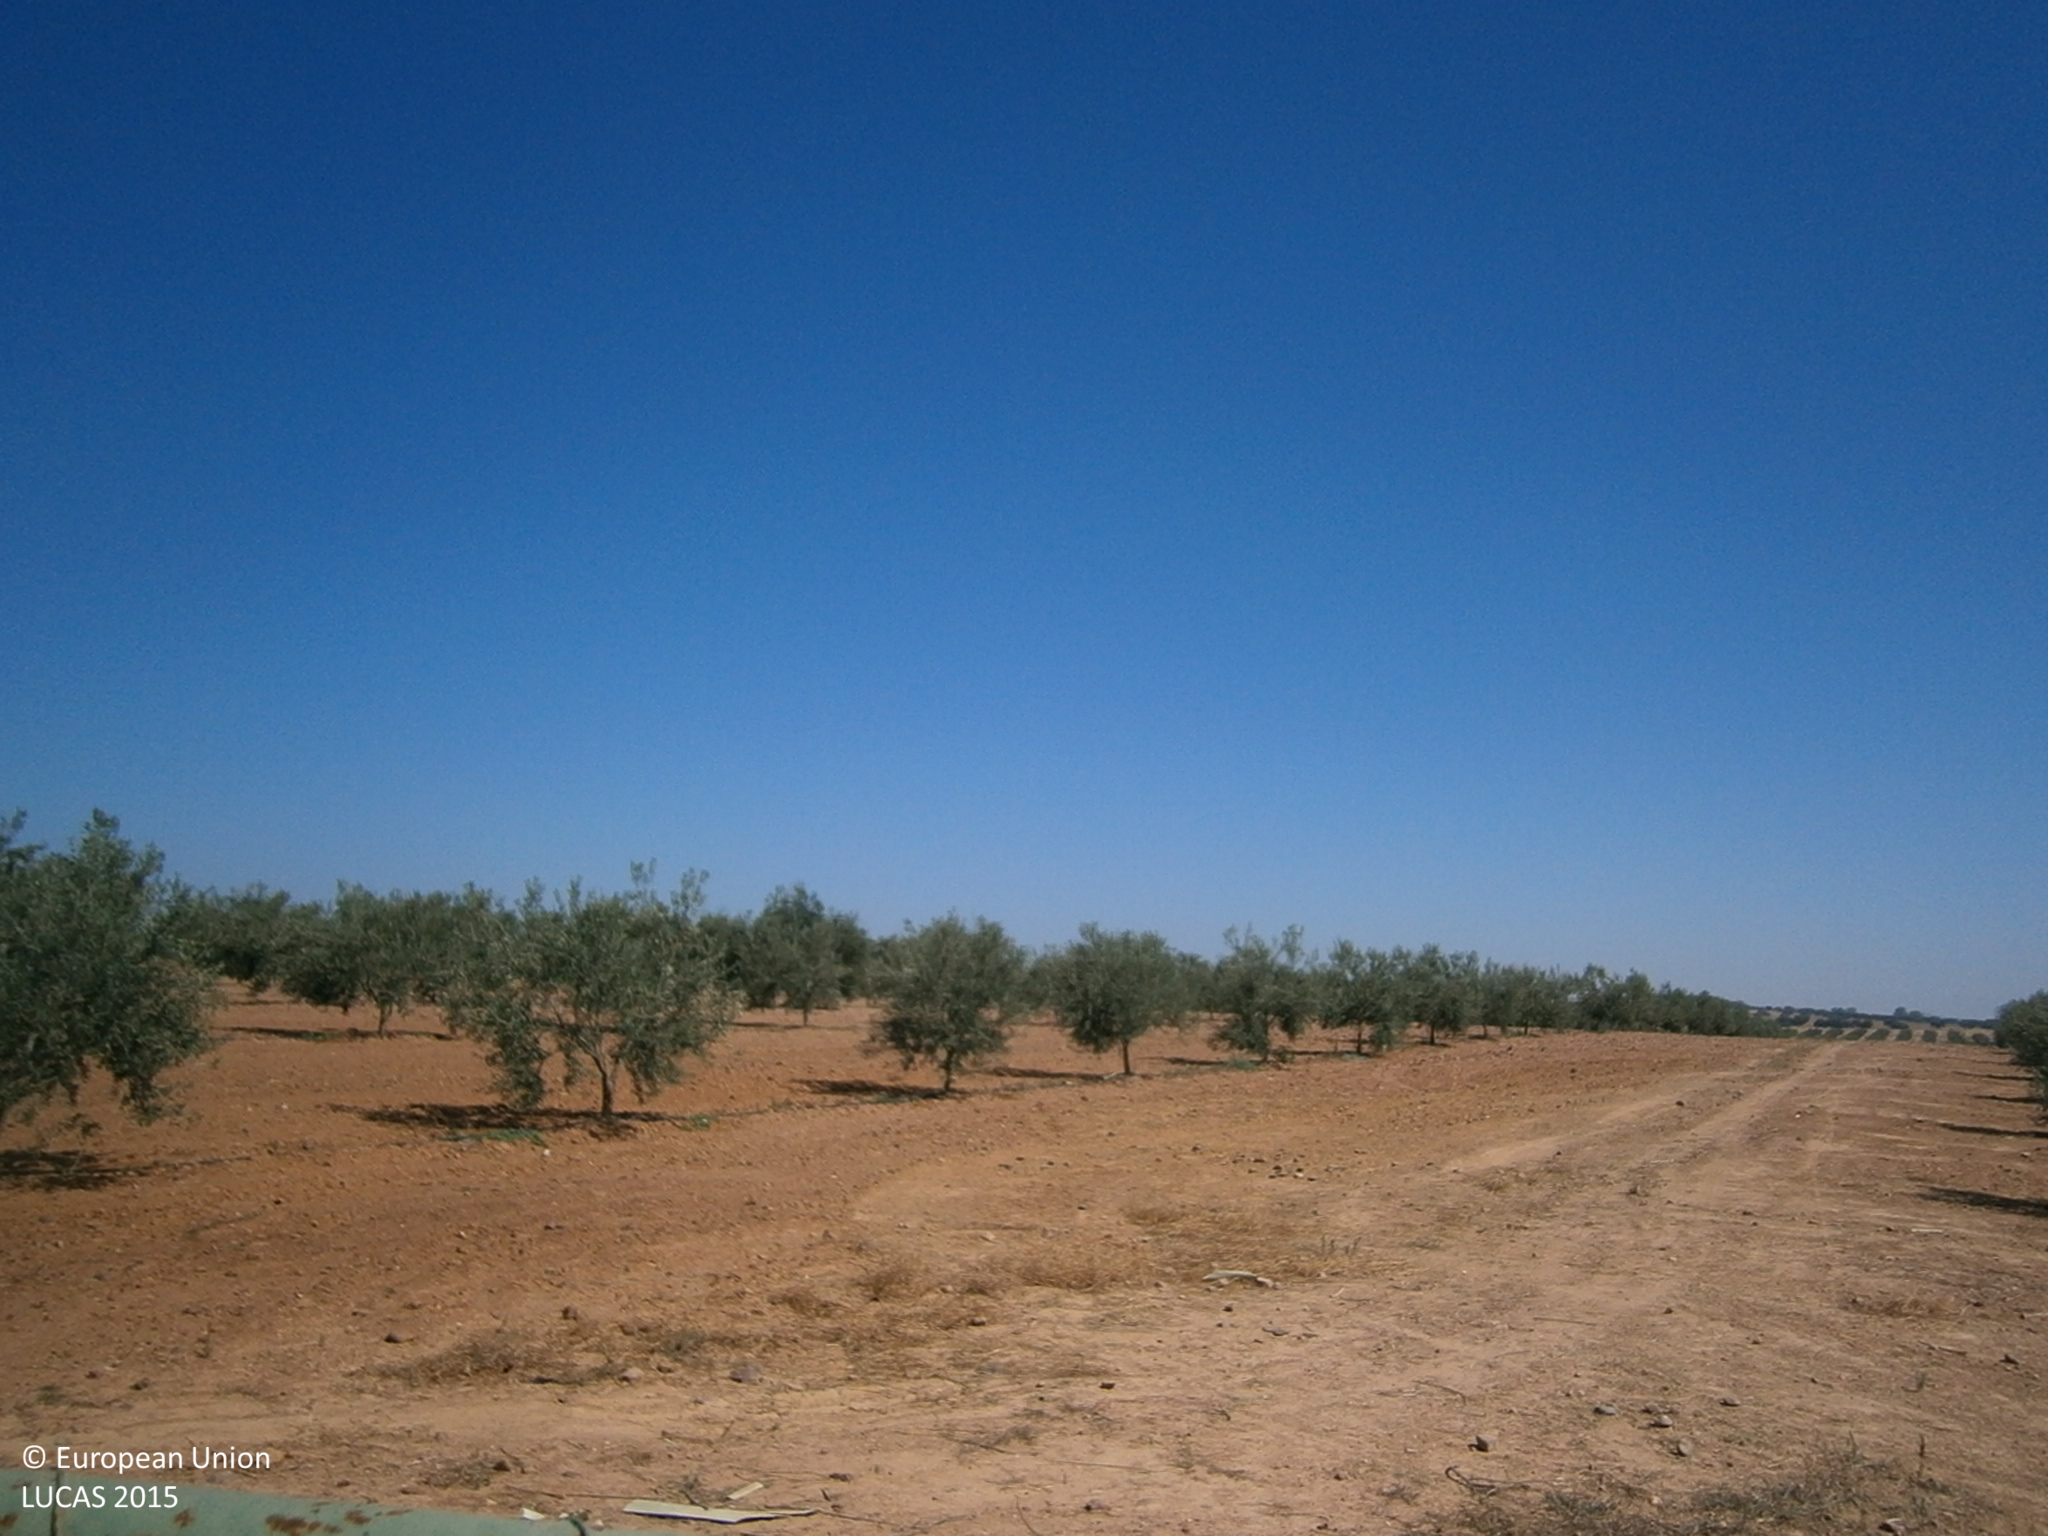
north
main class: Cropland
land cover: Olive groves
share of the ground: 25 - 50 %
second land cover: Other bare soil
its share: > 75 %
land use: Agriculture (excluding fallow land and kitchen gardens)
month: July
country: ES
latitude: 38.9622
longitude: -6.8605
